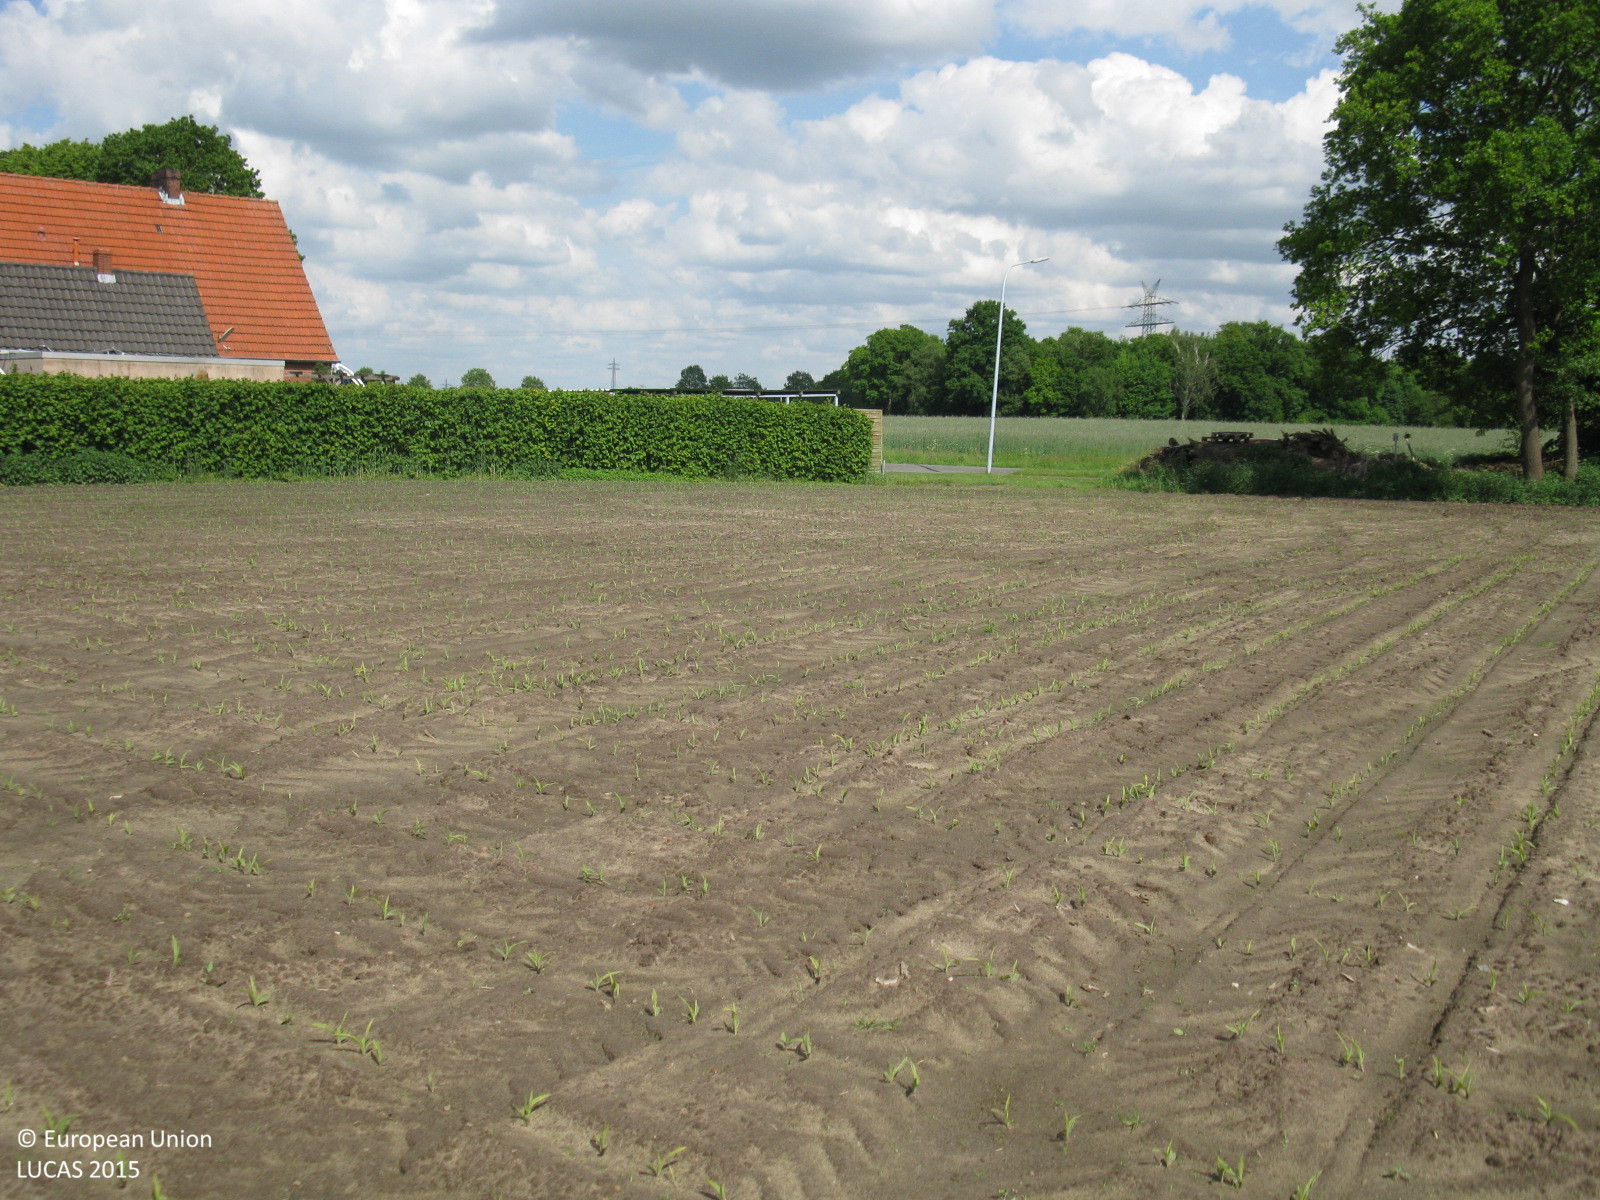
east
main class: Cropland
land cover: Maize
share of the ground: < 10 %
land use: Agriculture (excluding fallow land and kitchen gardens)
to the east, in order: Maize; Grassland without tree/shrub cover; Paved roads, cycling and walking lanes; Grass margins; Paved roads, cycling and walking lanes; Grassland without tree/shrub cover; Rye
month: June
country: DE
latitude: 53.0854
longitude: 7.3579
